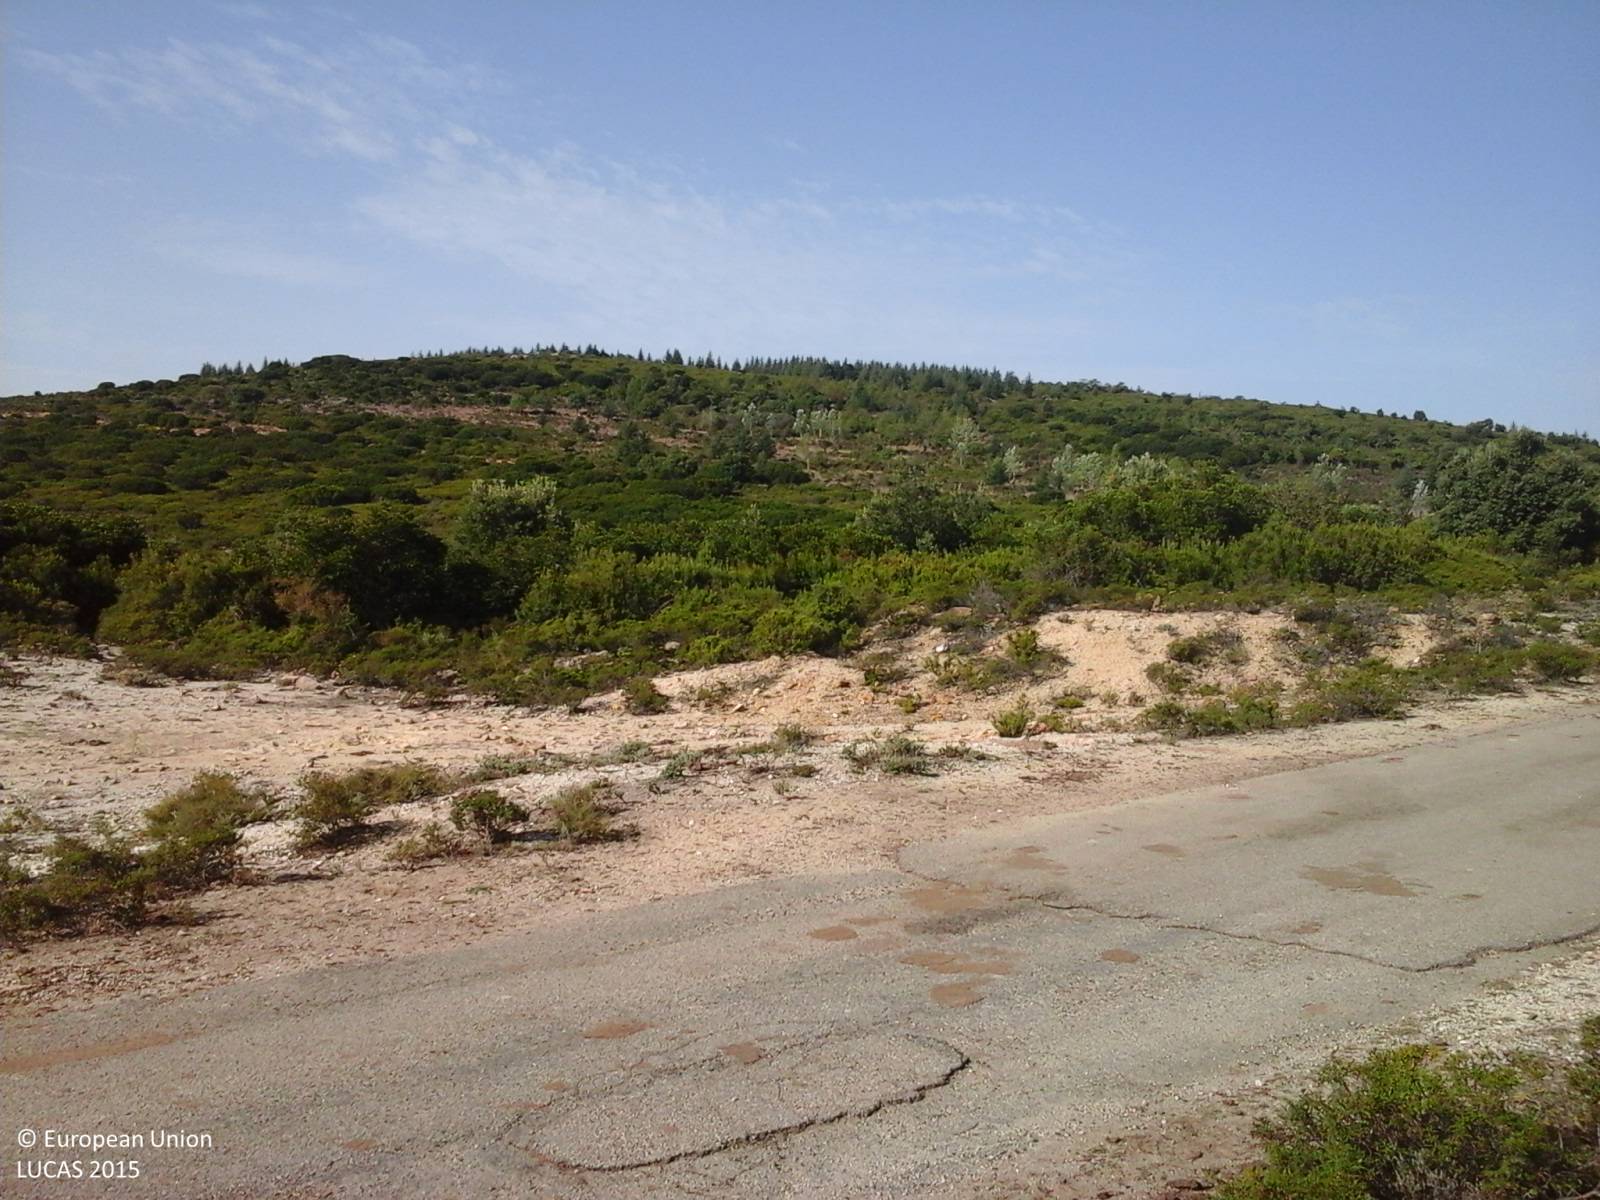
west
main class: Shrubland
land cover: Shrubland without tree cover
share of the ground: > 75 %
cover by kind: shrubs 75 %, herbaceous plants 15 %, consolidated bare surface 5 %, unconsolidated bare surface 5 %
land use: Agriculture (excluding fallow land and kitchen gardens)
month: September
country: IT
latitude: 39.8849
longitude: 9.3372
